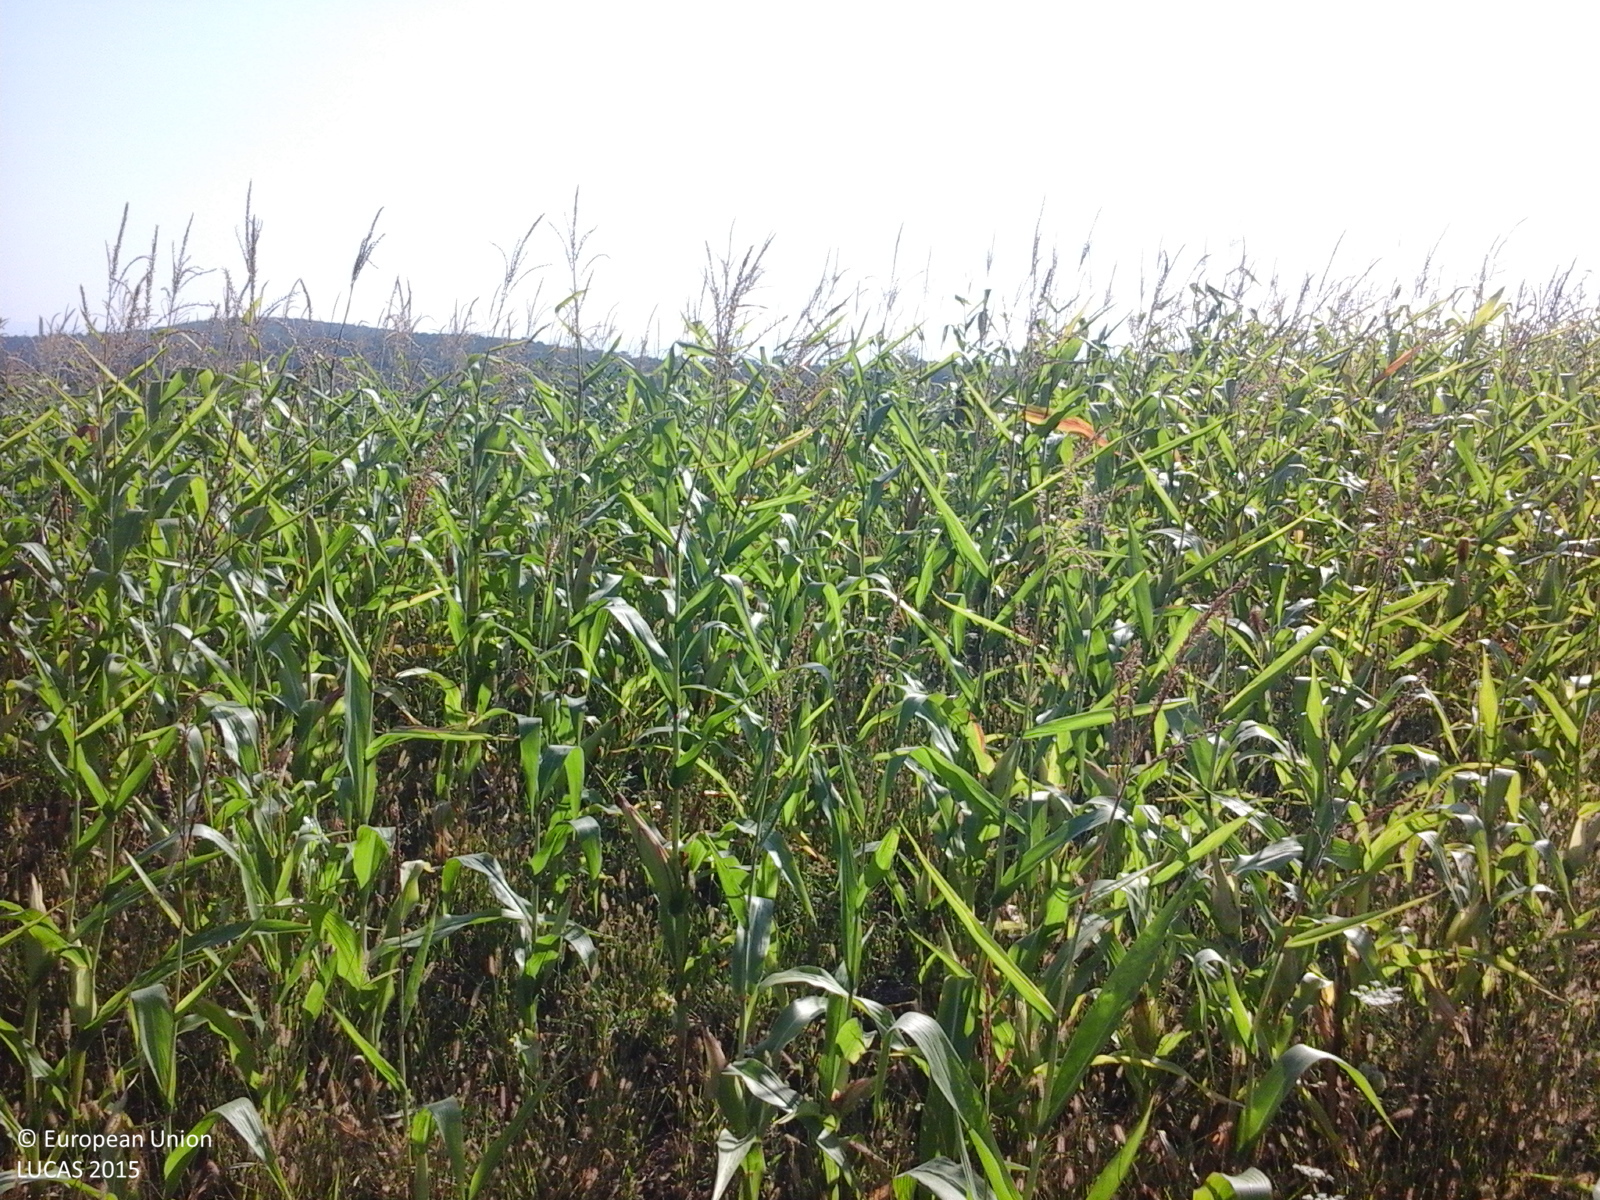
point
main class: Cropland
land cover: Maize
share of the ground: > 75 %
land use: Agriculture (excluding fallow land and kitchen gardens)
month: September
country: RO
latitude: 47.2691
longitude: 22.6813
